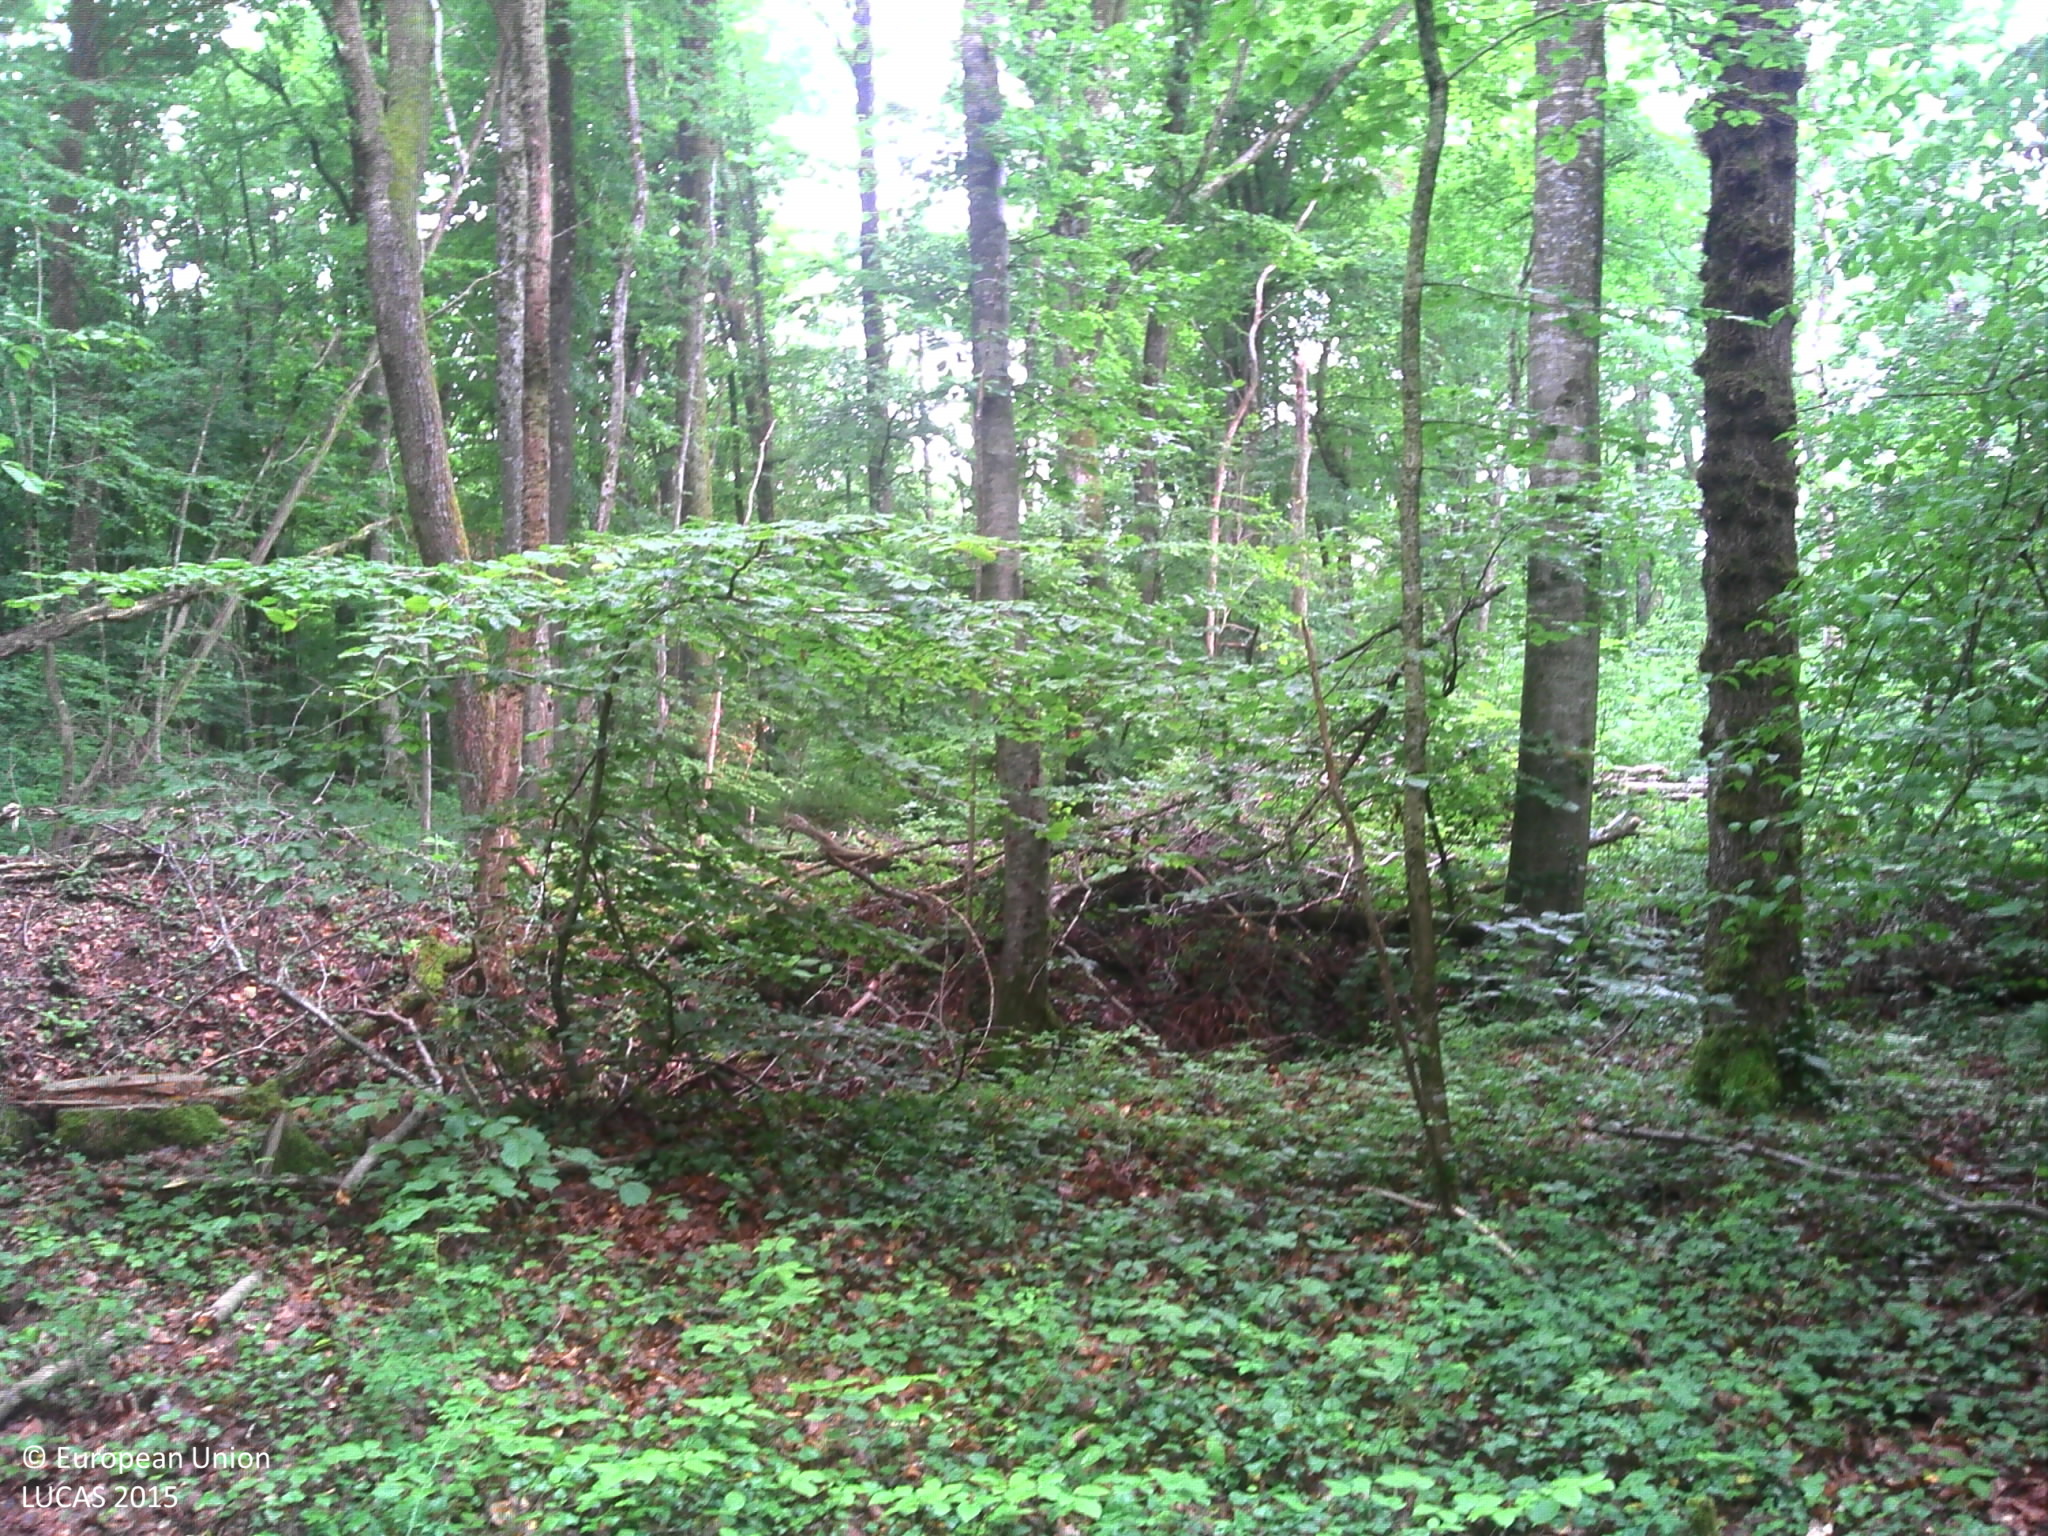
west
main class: Woodland
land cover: Broadleaved woodland
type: mesophytic deciduous forest
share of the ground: > 75 %
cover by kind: broadleaved forest trees 90 %, herbaceous plants 10 %
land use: Forestry
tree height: > 5 m
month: June
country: FR
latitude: 48.2173
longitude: 4.9785
